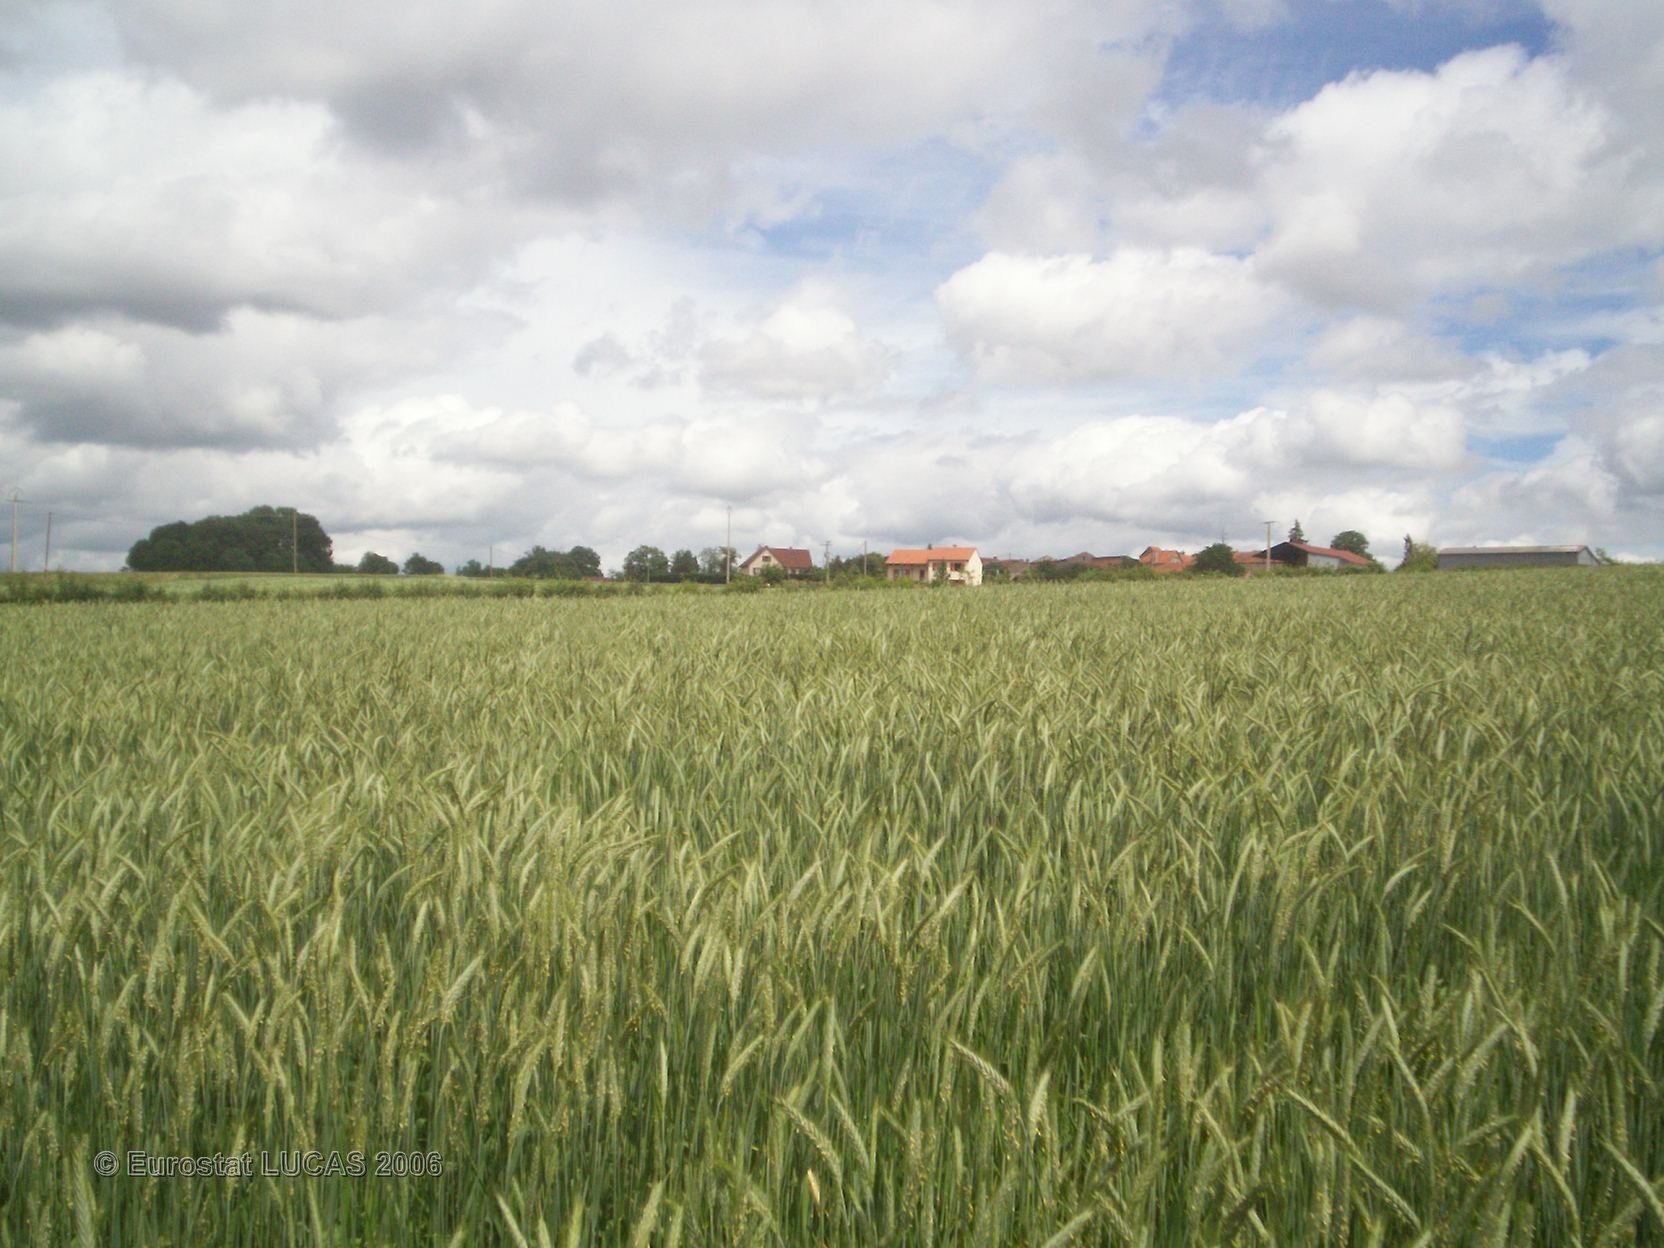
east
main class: Cropland
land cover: Triticale
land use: Agriculture (excluding fallow land and kitchen gardens)
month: May
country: FR
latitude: 46.1496
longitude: 3.1496
